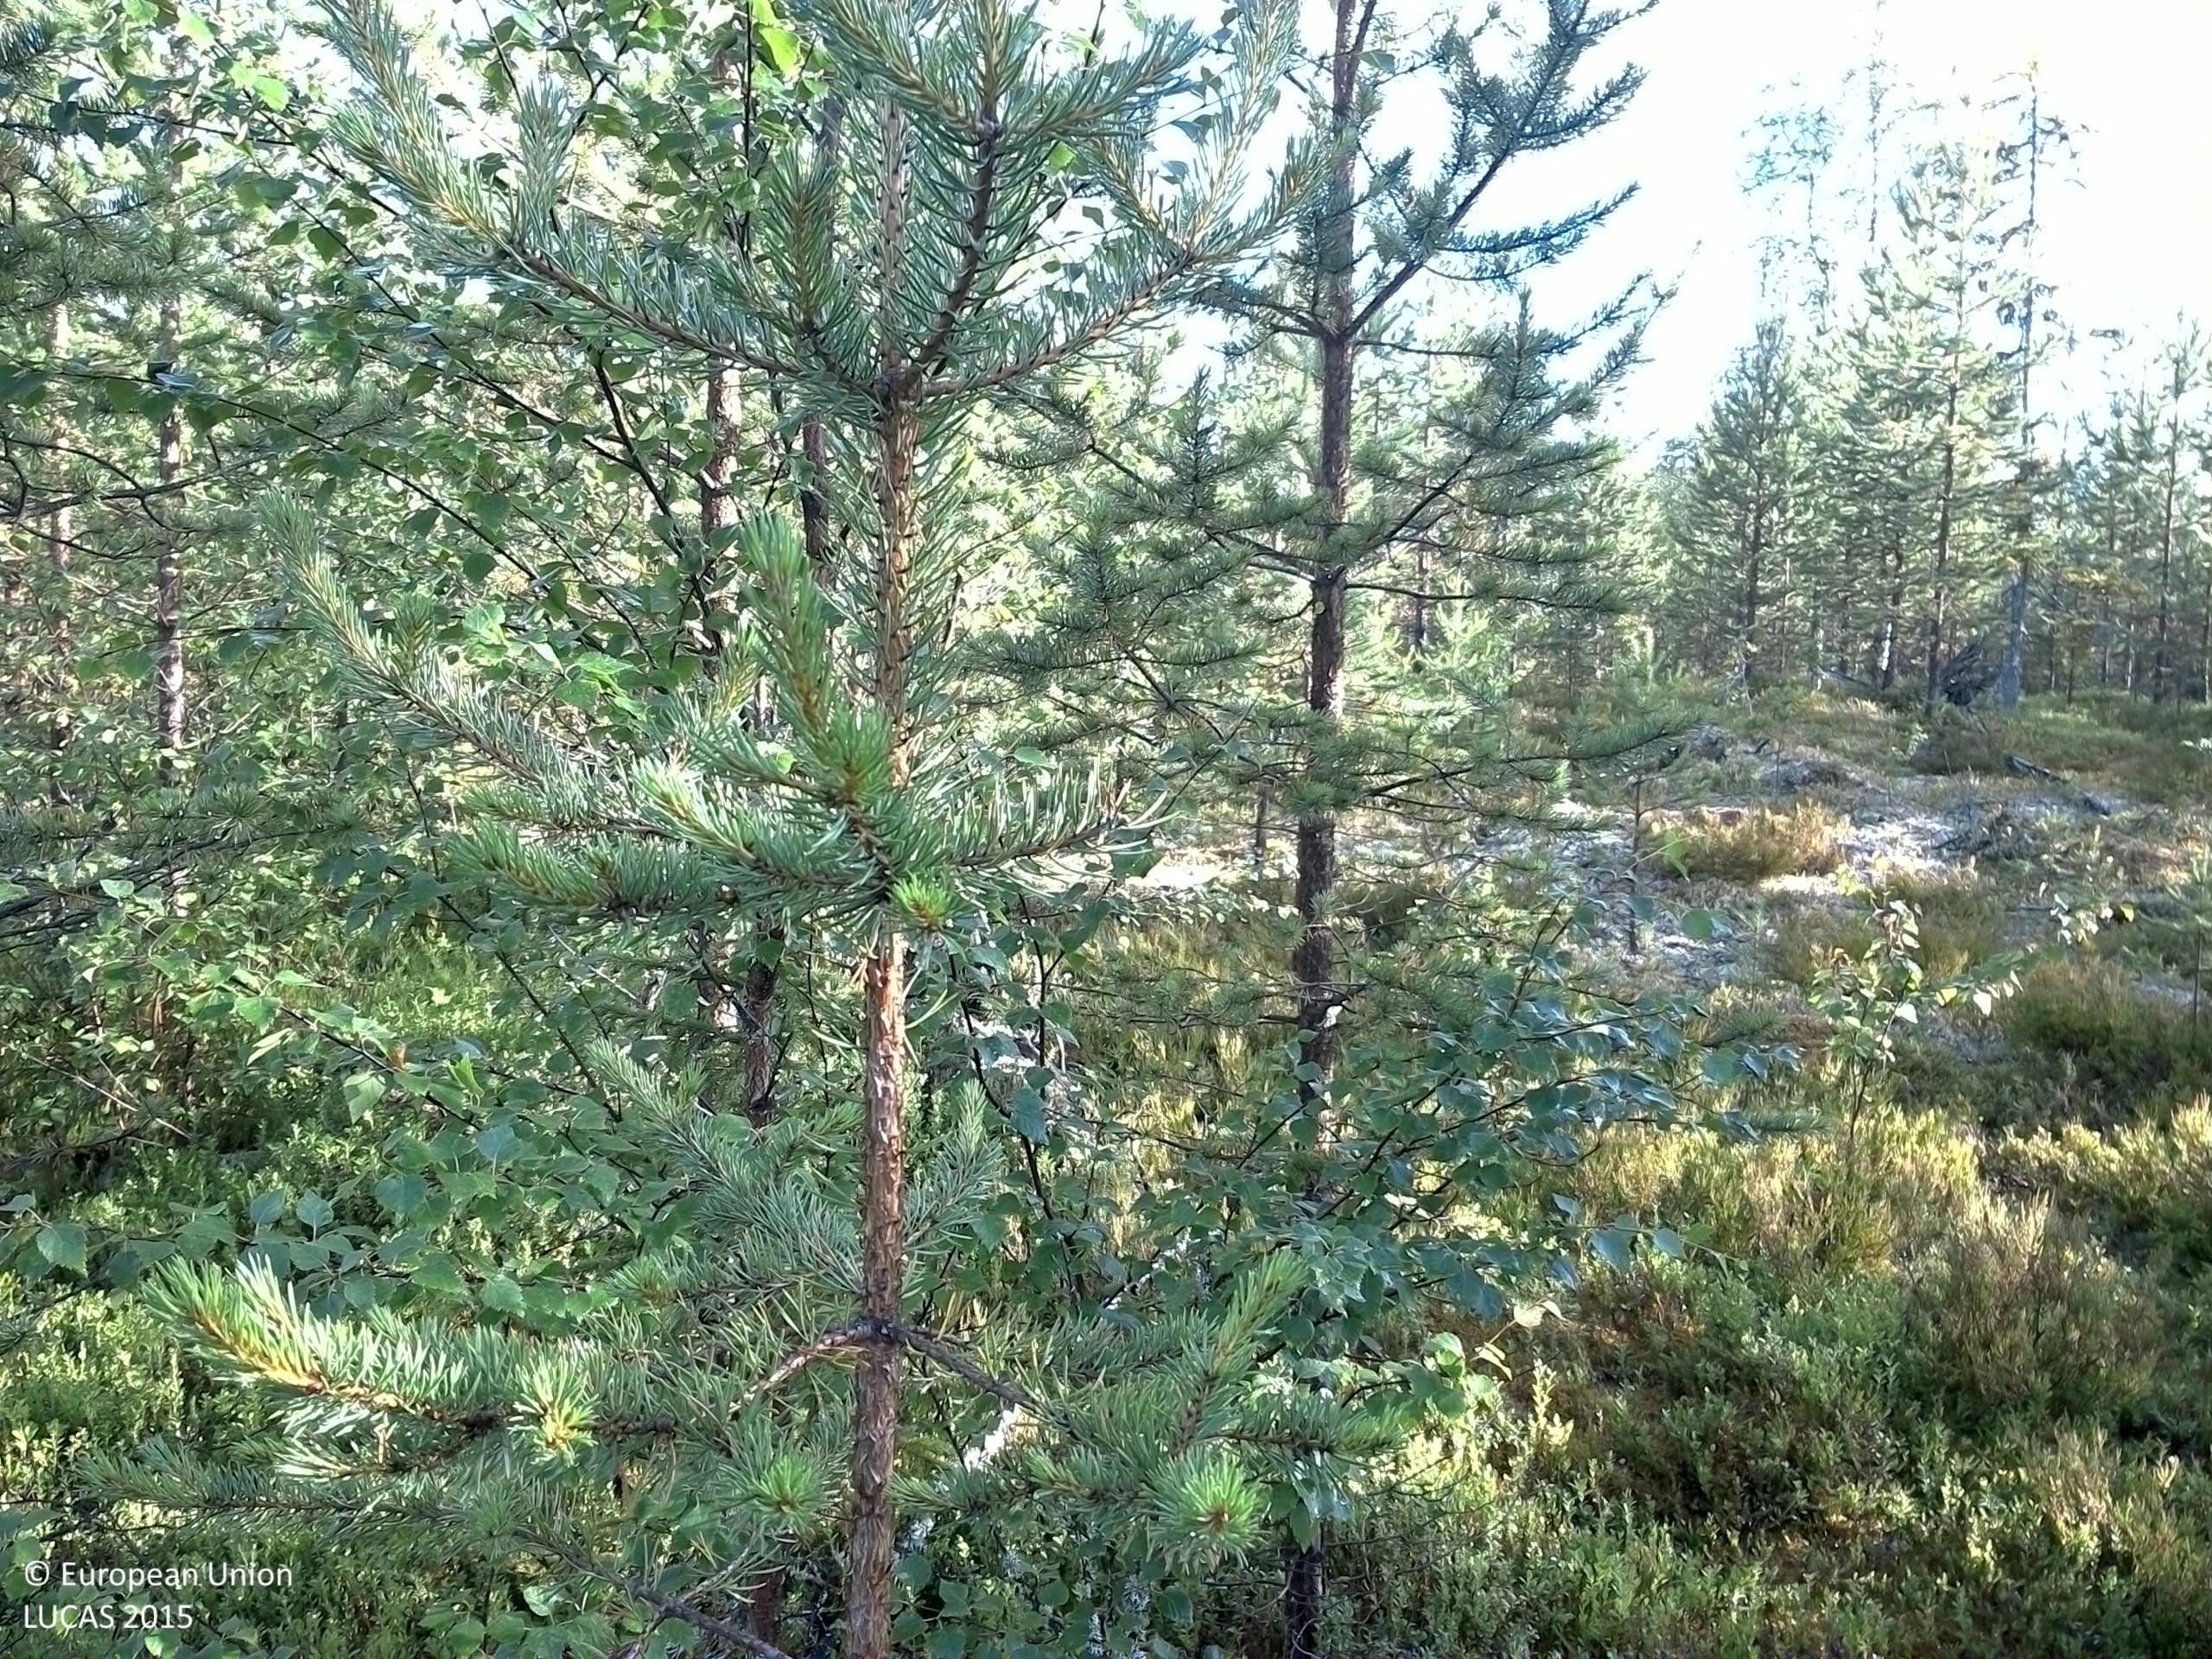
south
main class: Woodland
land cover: Pine dominated coniferous woodland
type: boreal forest
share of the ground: 25 - 50 %
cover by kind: coniferous forest trees 40 %, shrubs 35 %, lichens and mosses 15 %, broadleaved forest trees 5 %, consolidated bare surface 5 %
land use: Forestry
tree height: < 5 m
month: July
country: SE
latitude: 63.8022
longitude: 17.1386
